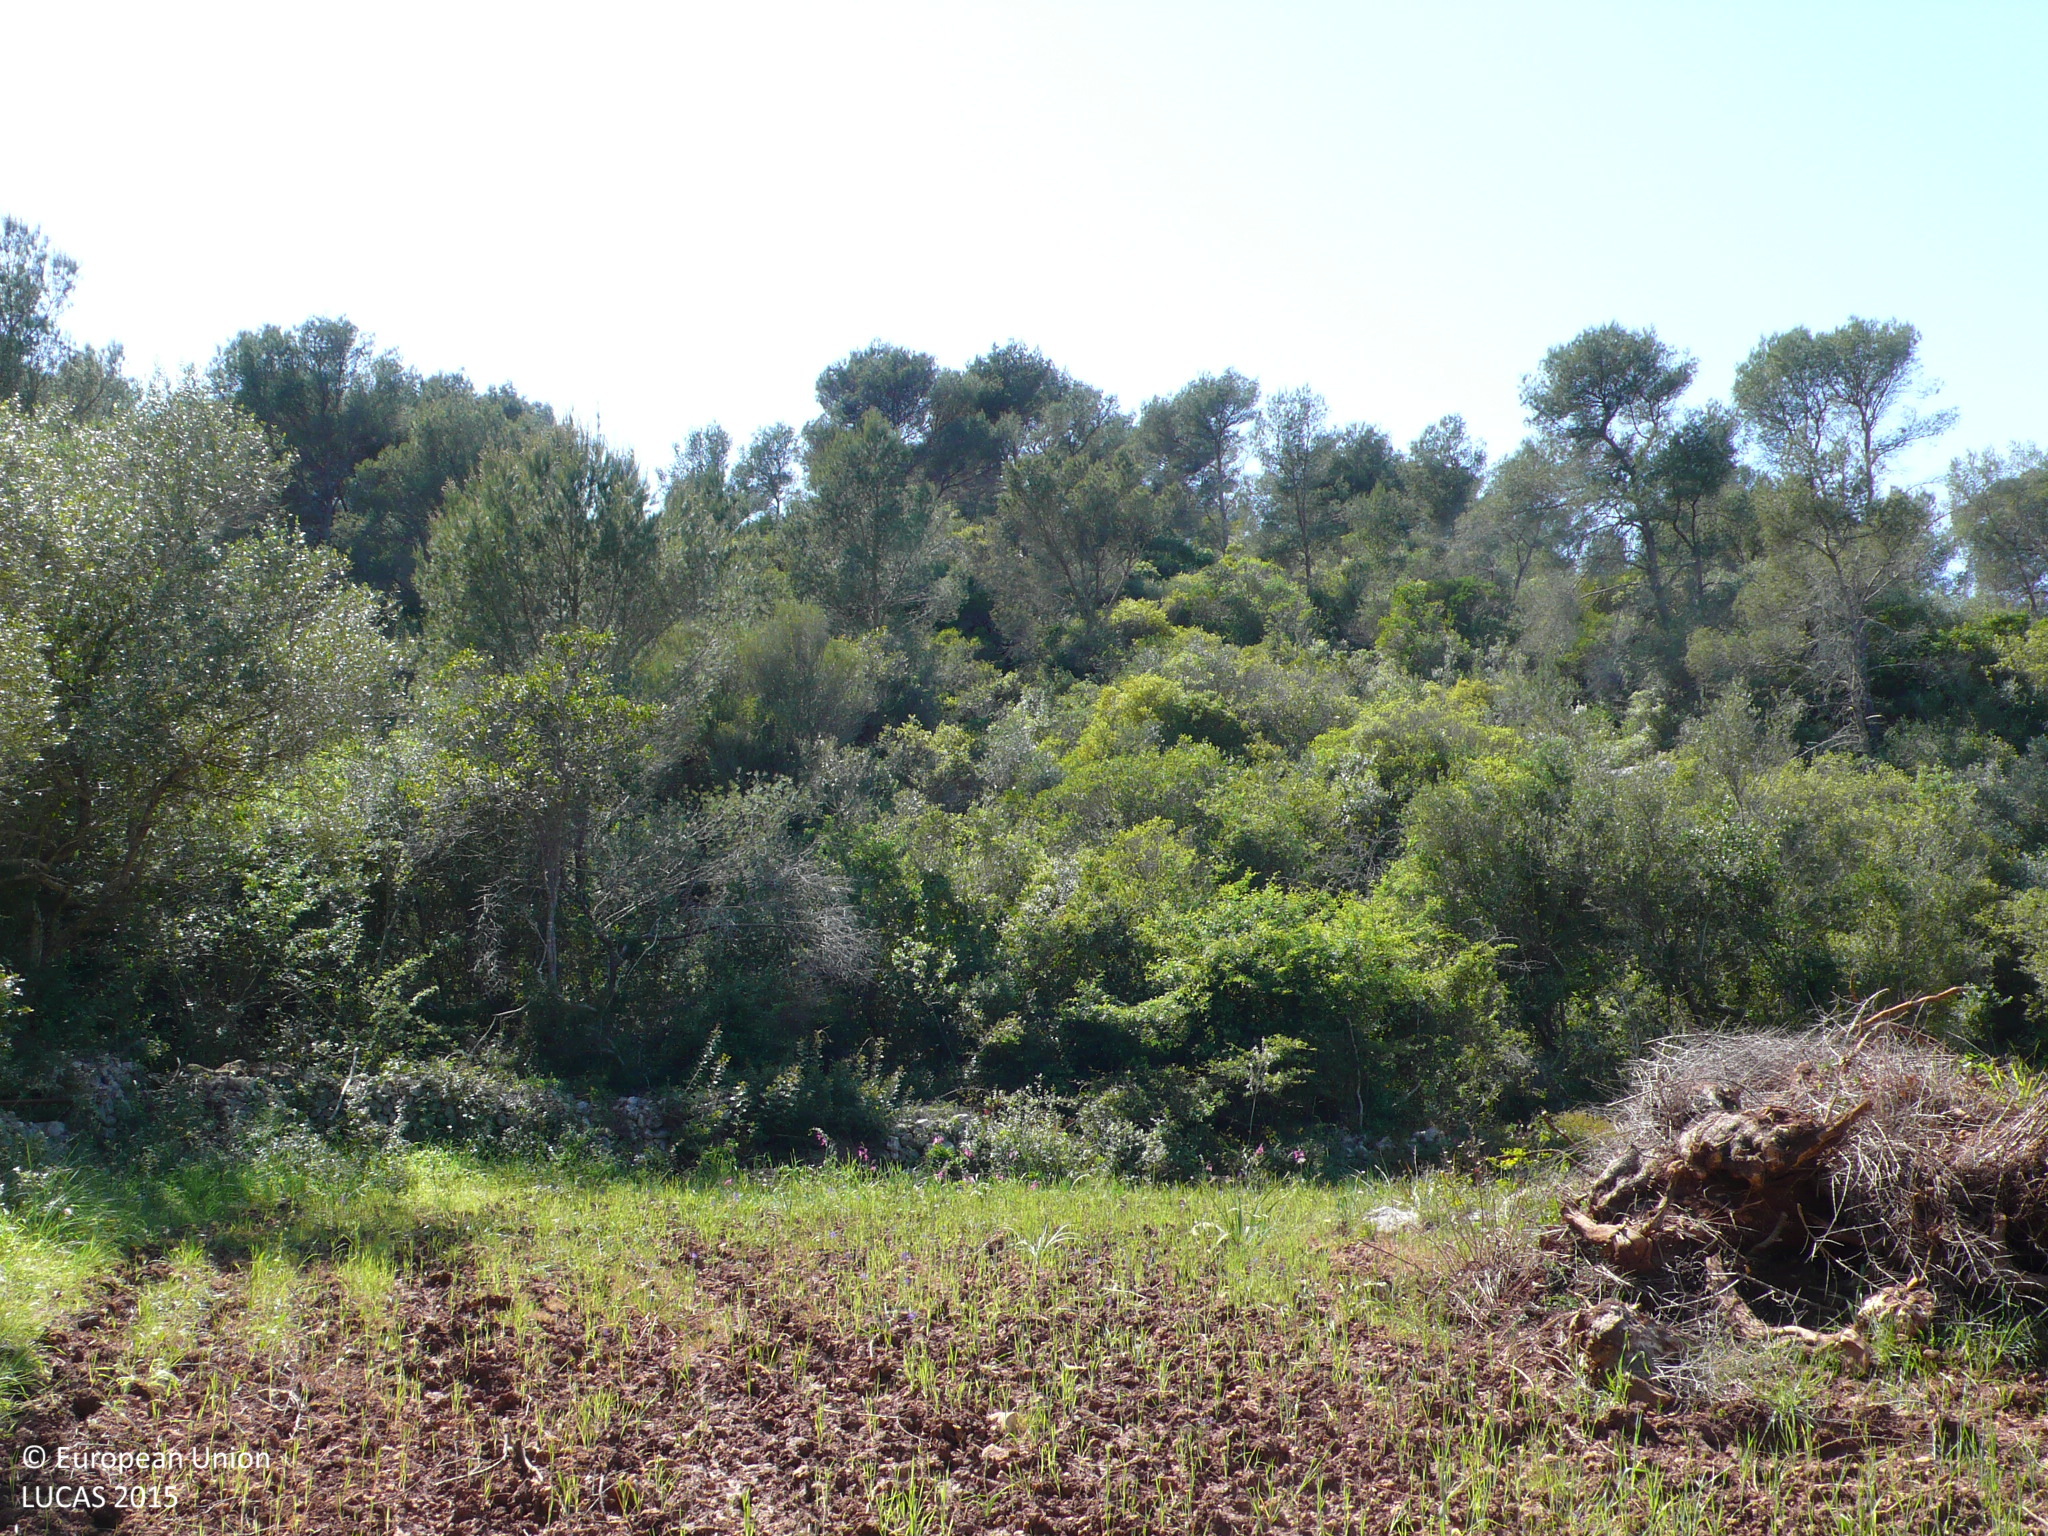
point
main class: Woodland
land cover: Other mixed woodland
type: coniferous forest of the mediterranean region
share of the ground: > 75 %
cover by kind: coniferous forest trees 50 %, broadleaved forest trees 45 %, shrubs 5 %
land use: Semi-natural and natural areas not in use
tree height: > 5 m
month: May
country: ES
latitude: 39.9260
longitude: 4.0940
